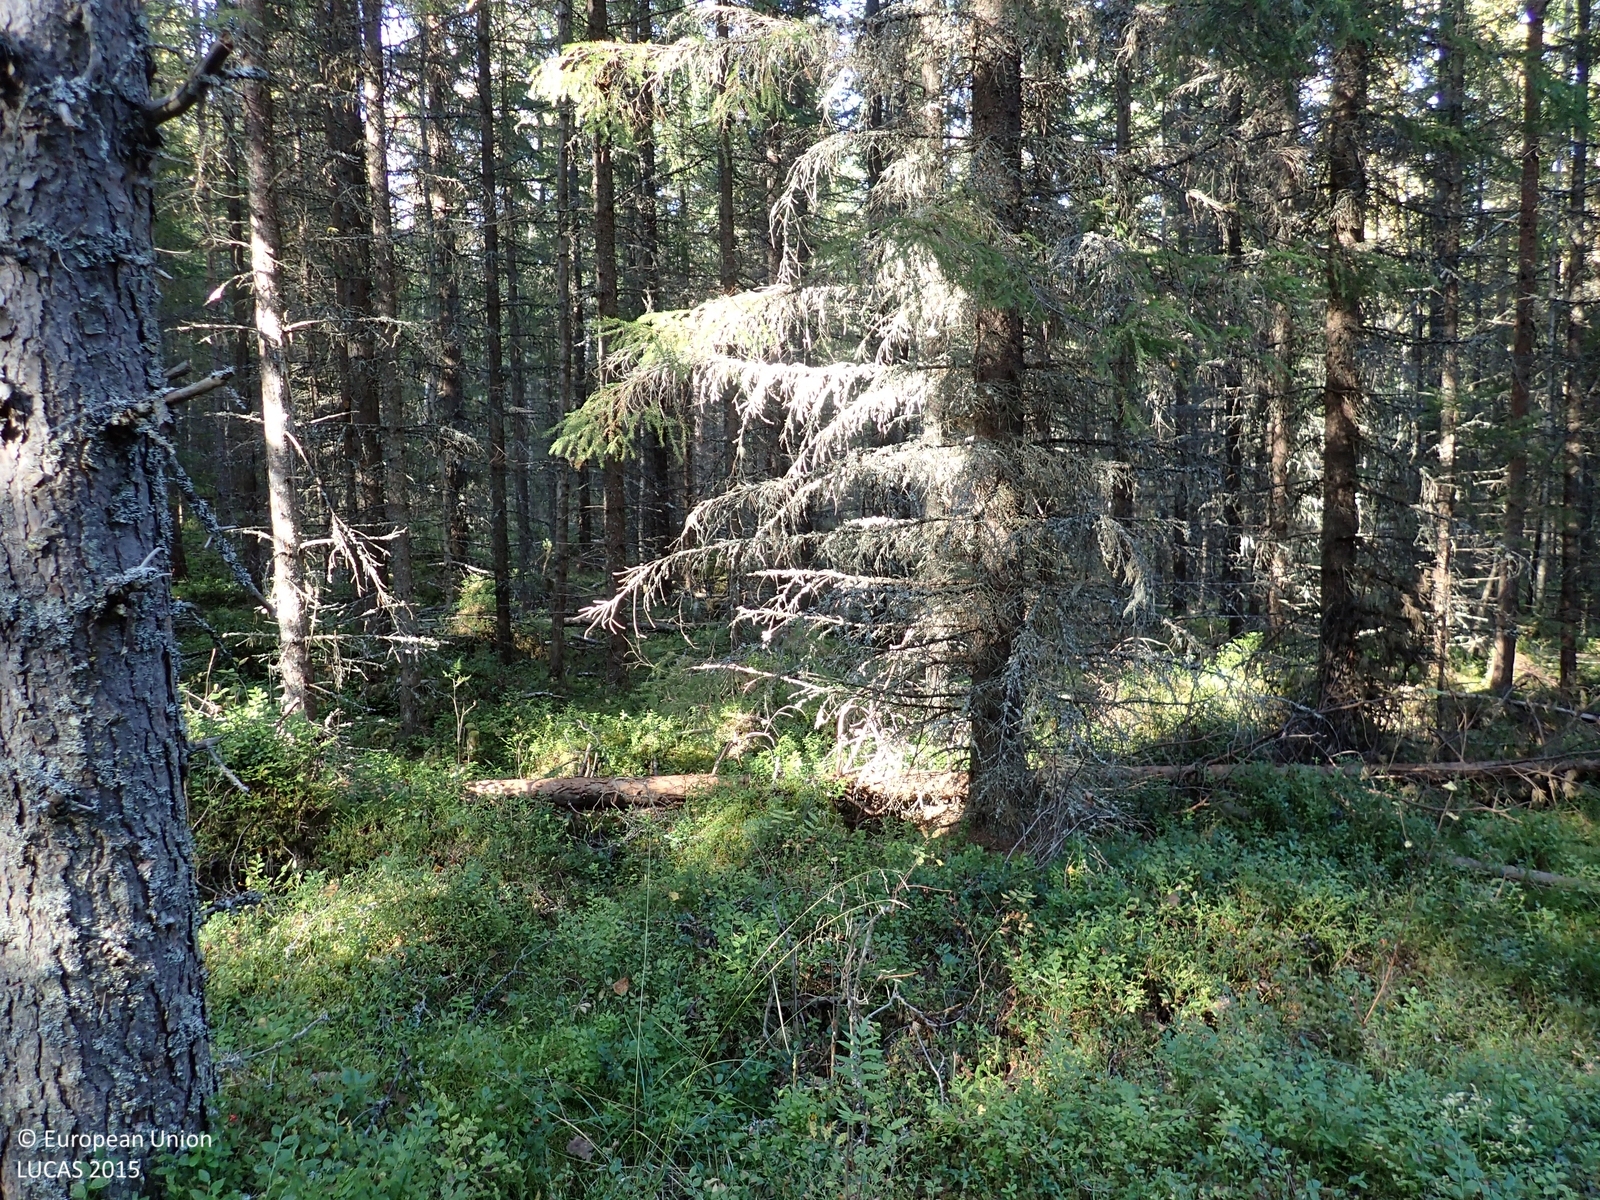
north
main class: Woodland
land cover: Spruce dominated coniferous woodland
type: boreal forest
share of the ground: > 75 %
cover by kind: coniferous forest trees 70 %, shrubs 15 %, broadleaved forest trees 10 %, lichens and mosses 5 %
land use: Forestry
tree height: > 5 m
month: September
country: FI
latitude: 62.9075
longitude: 25.5187
